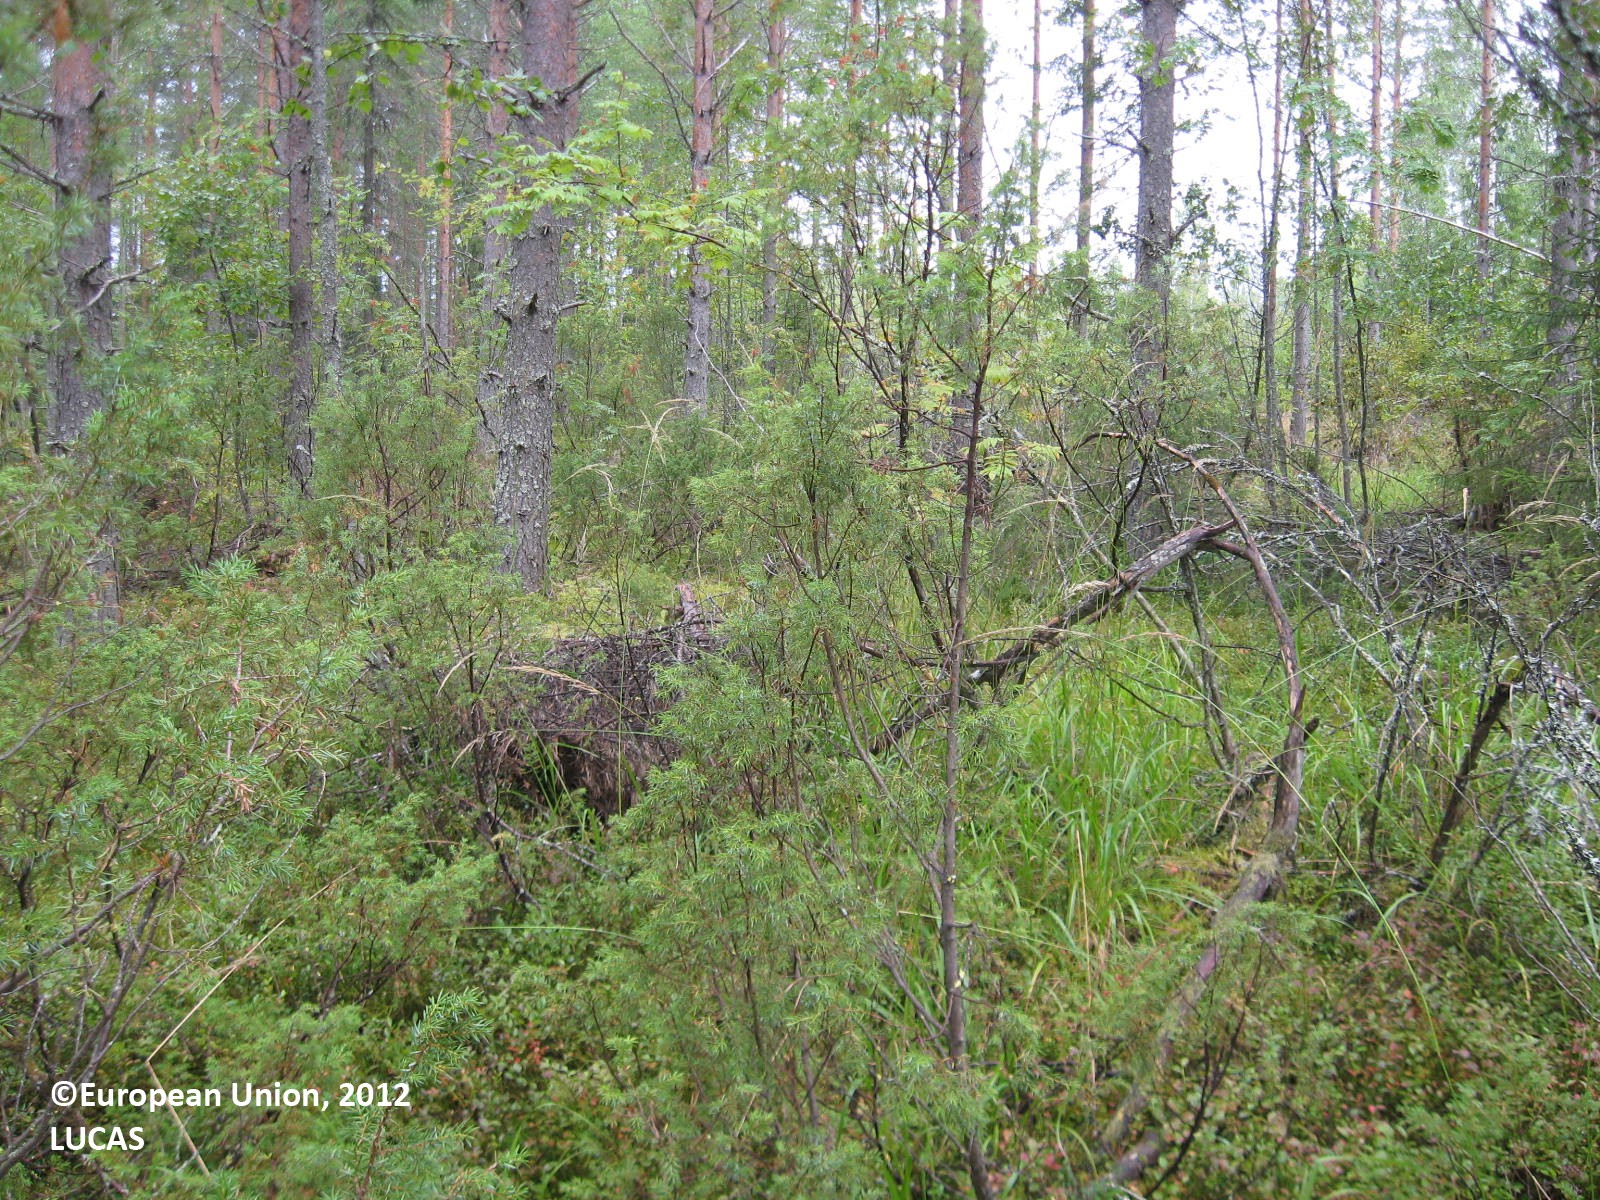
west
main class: Woodland
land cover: Pine dominated coniferous woodland
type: boreal forest
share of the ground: > 75 %
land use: Forestry
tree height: > 5 m
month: August
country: FI
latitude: 63.4999
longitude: 29.8261
